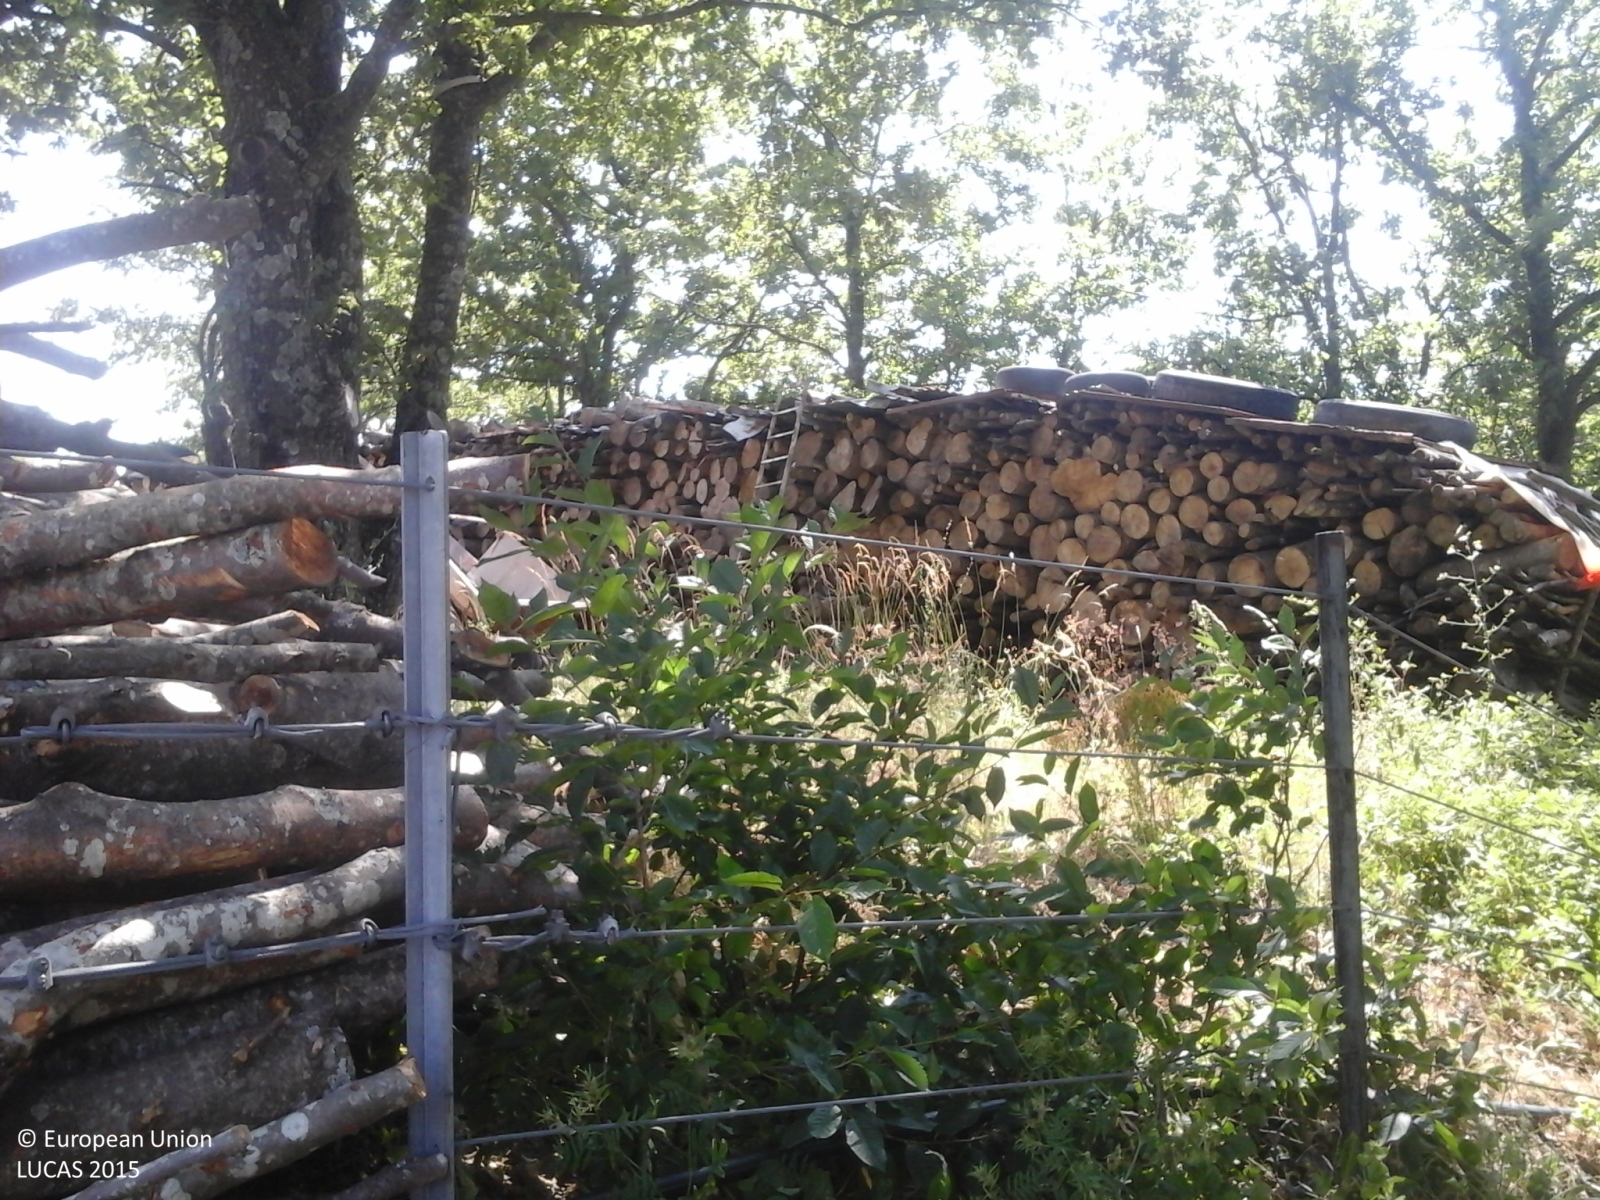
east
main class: Woodland
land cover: Broadleaved woodland
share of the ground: > 75 %
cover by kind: broadleaved forest trees 85 %
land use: Agriculture (excluding fallow land and kitchen gardens)
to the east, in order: Broadleaved woodland; Artificial constructions; Managed hedges; Ditches and canals; Tracks; Managed hedges; Grassland without tree/shrub cover; Tracks; Grassland without tree/shrub cover; Broadleaved woodland
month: July
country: IT
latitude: 44.3501
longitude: 10.2879
